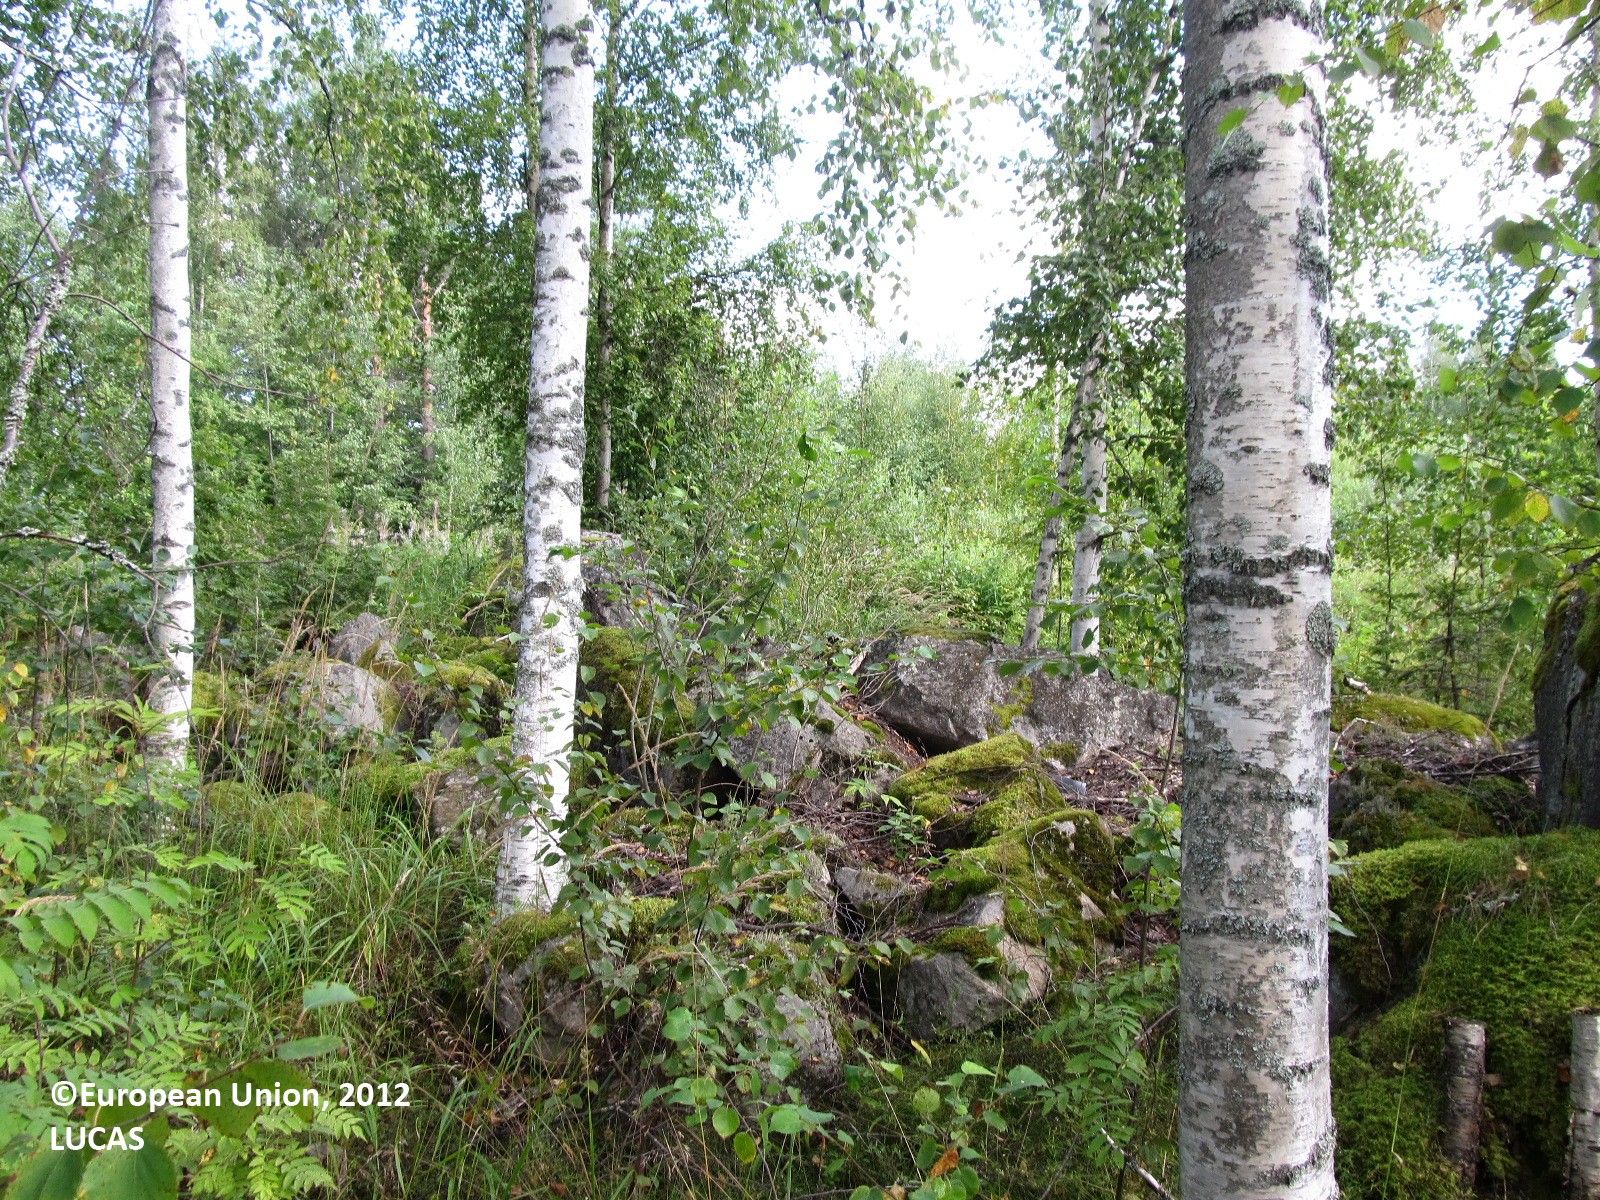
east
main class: Woodland
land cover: Broadleaved woodland
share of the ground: 25 - 50 %
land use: Forestry
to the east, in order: Broadleaved woodland; Ditches and canals; Grassland without tree/shrub cover; Broadleaved woodland; Tracks; Broadleaved woodland
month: August
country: FI
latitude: 62.3235
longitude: 27.5990
